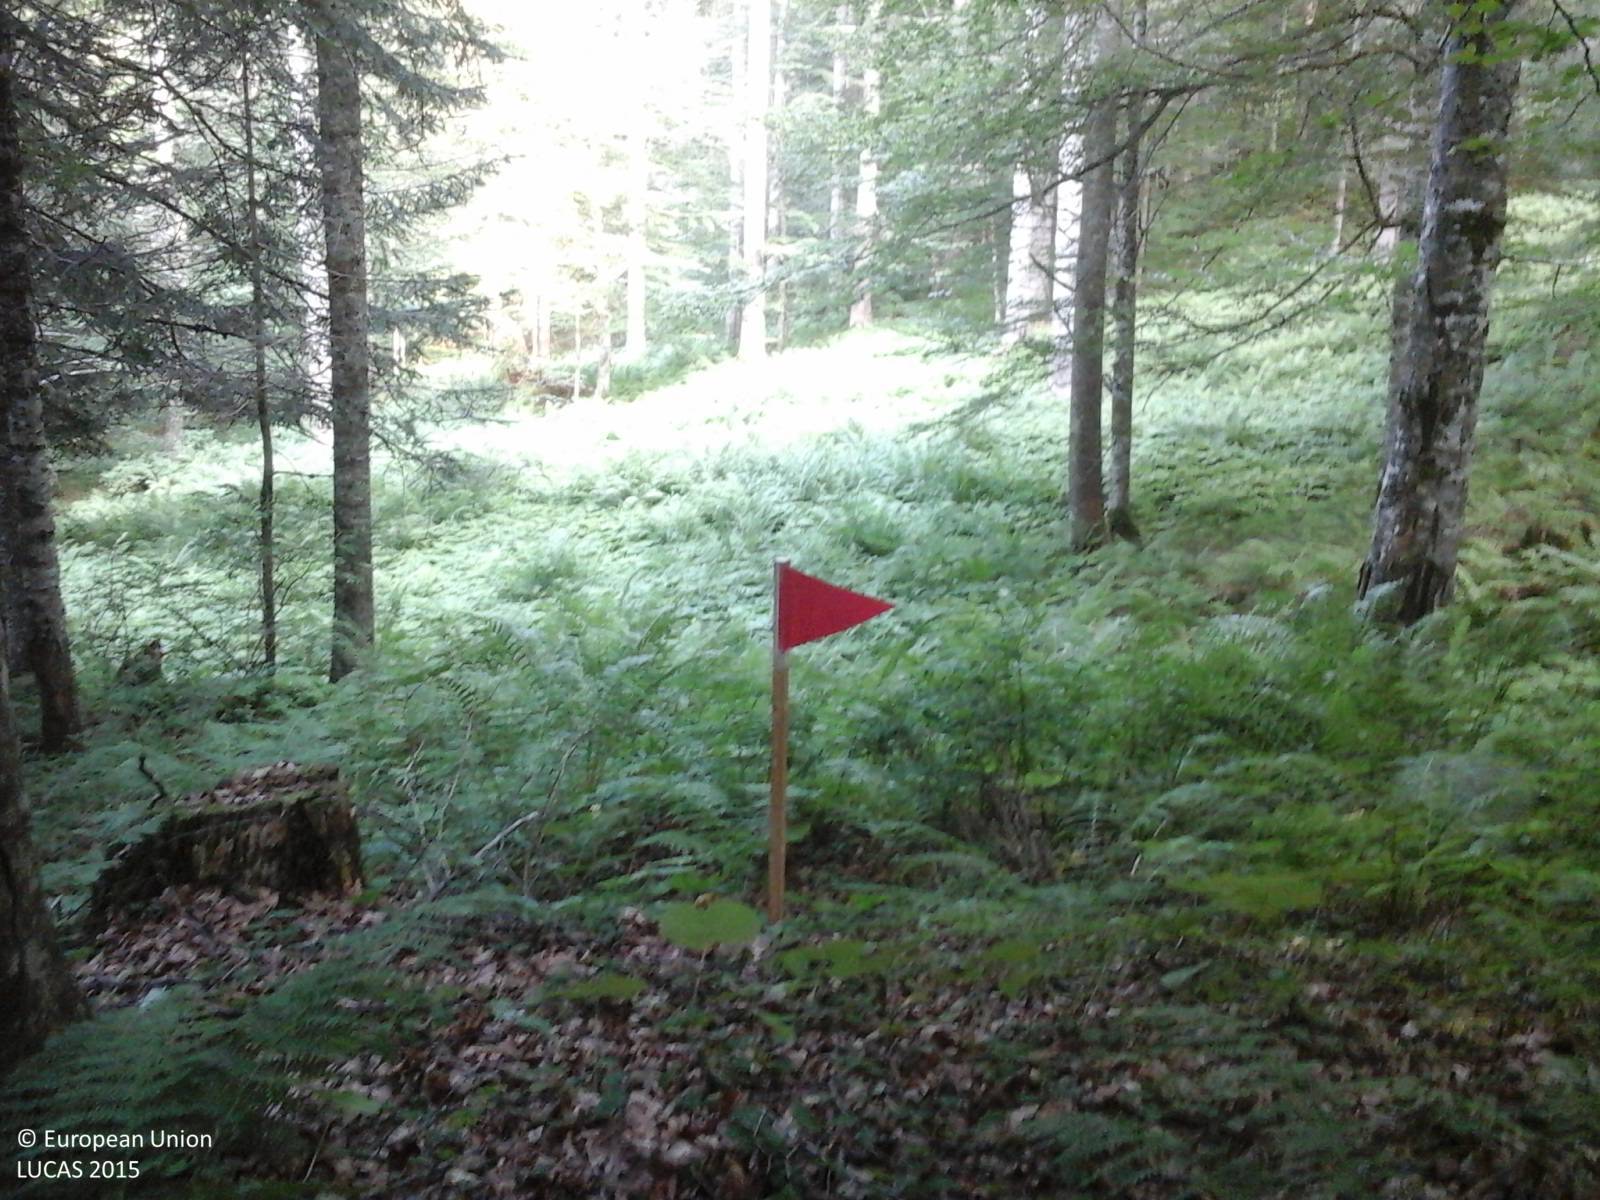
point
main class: Woodland
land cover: Spruce dominated mixed woodland
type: alpine coniferous forest
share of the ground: > 75 %
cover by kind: coniferous forest trees 65 %, broadleaved forest trees 30 %, herbaceous plants 5 %
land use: Forestry
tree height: > 5 m
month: July
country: IT
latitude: 46.4428
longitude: 12.7176
